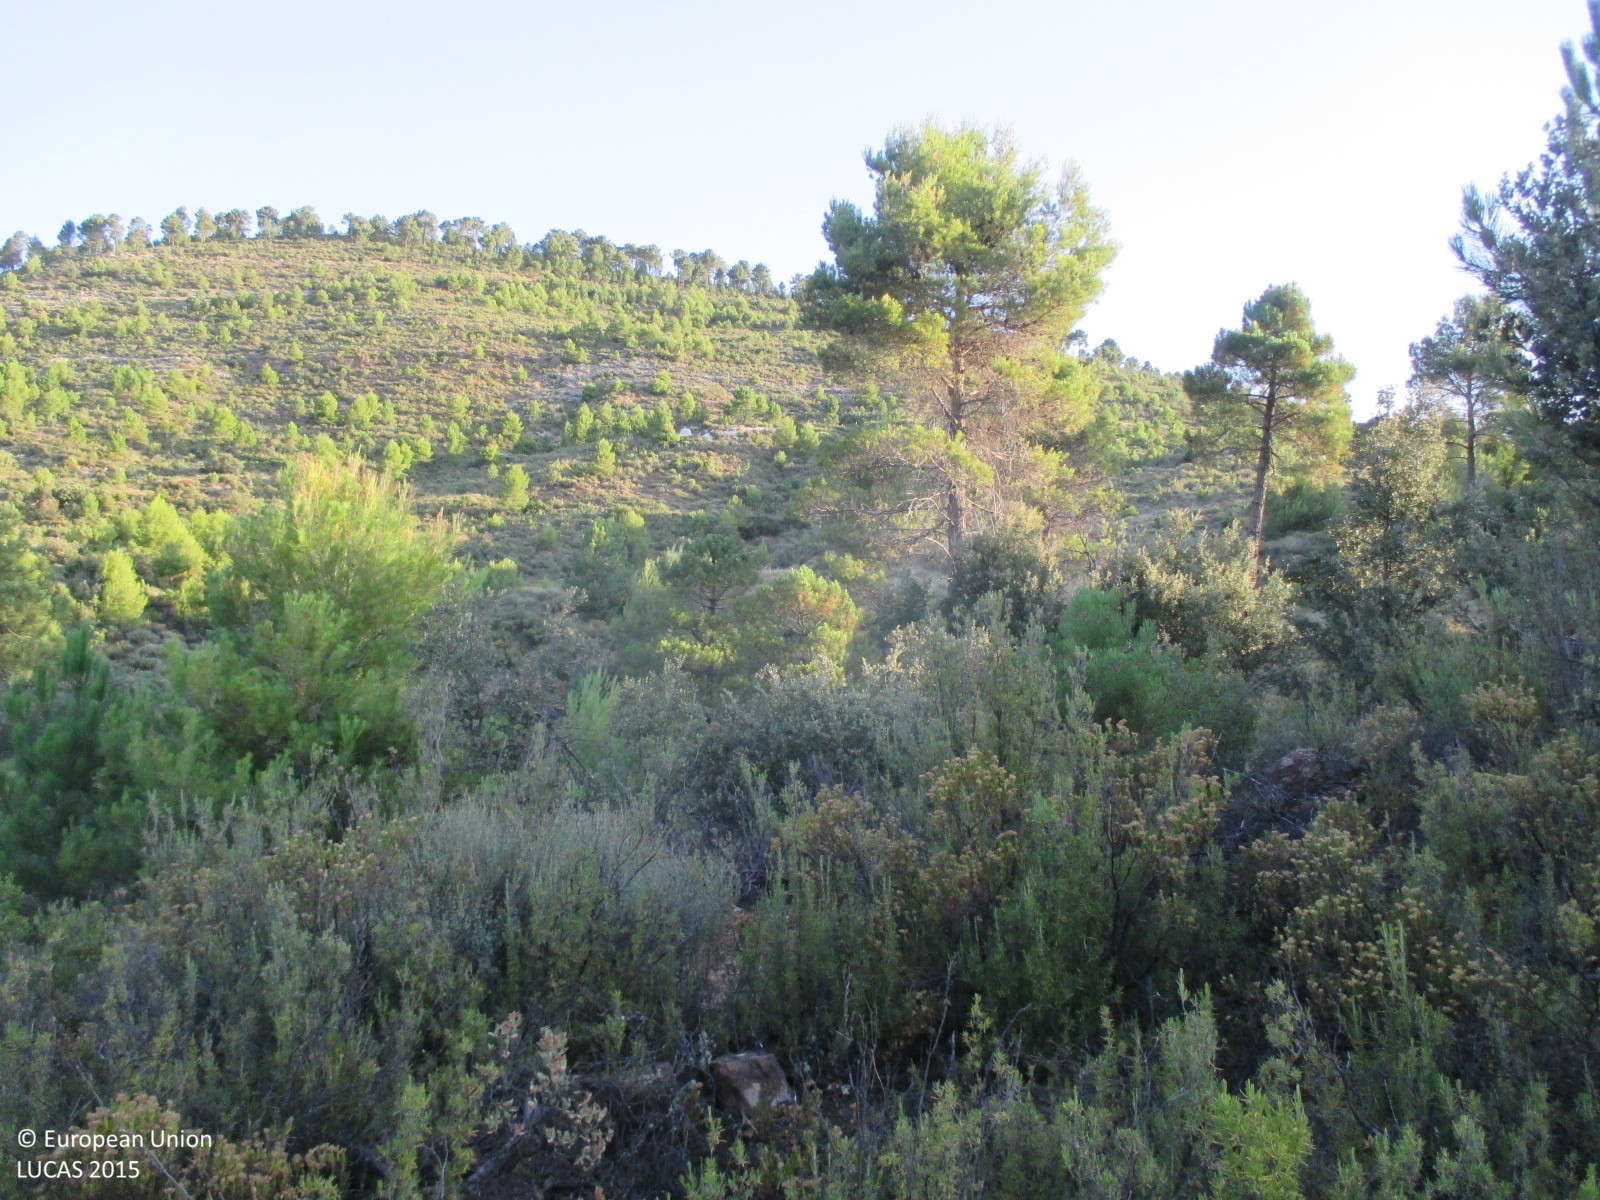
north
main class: Woodland
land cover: Pine dominated coniferous woodland
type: coniferous forest of the mediterranean region
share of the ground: 25 - 50 %
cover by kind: coniferous forest trees 40 %, shrubs 40 %, herbaceous plants 20 %
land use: Forestry
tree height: > 5 m
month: July
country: ES
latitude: 38.3447
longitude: -2.3875
